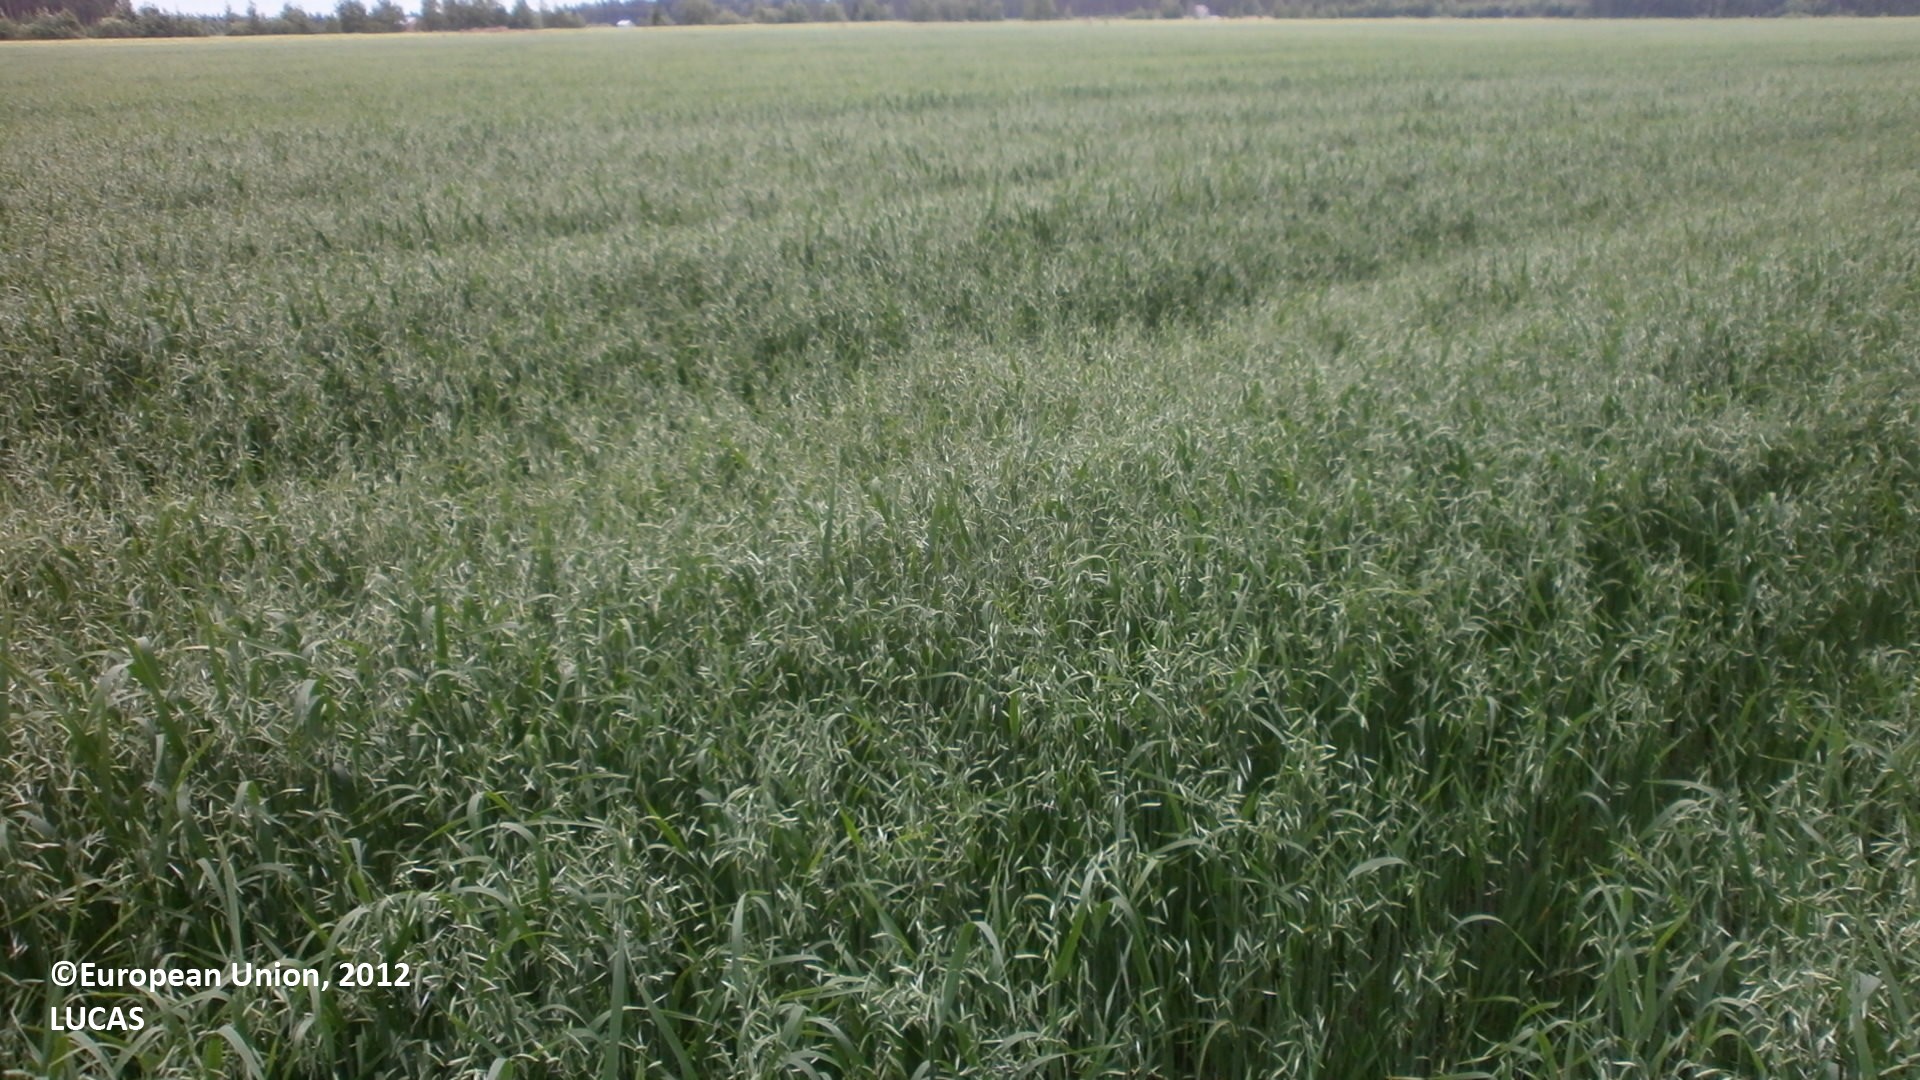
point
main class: Cropland
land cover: Oats
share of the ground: > 75 %
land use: Agriculture (excluding fallow land and kitchen gardens)
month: July
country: FI
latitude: 64.2422
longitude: 24.1101
